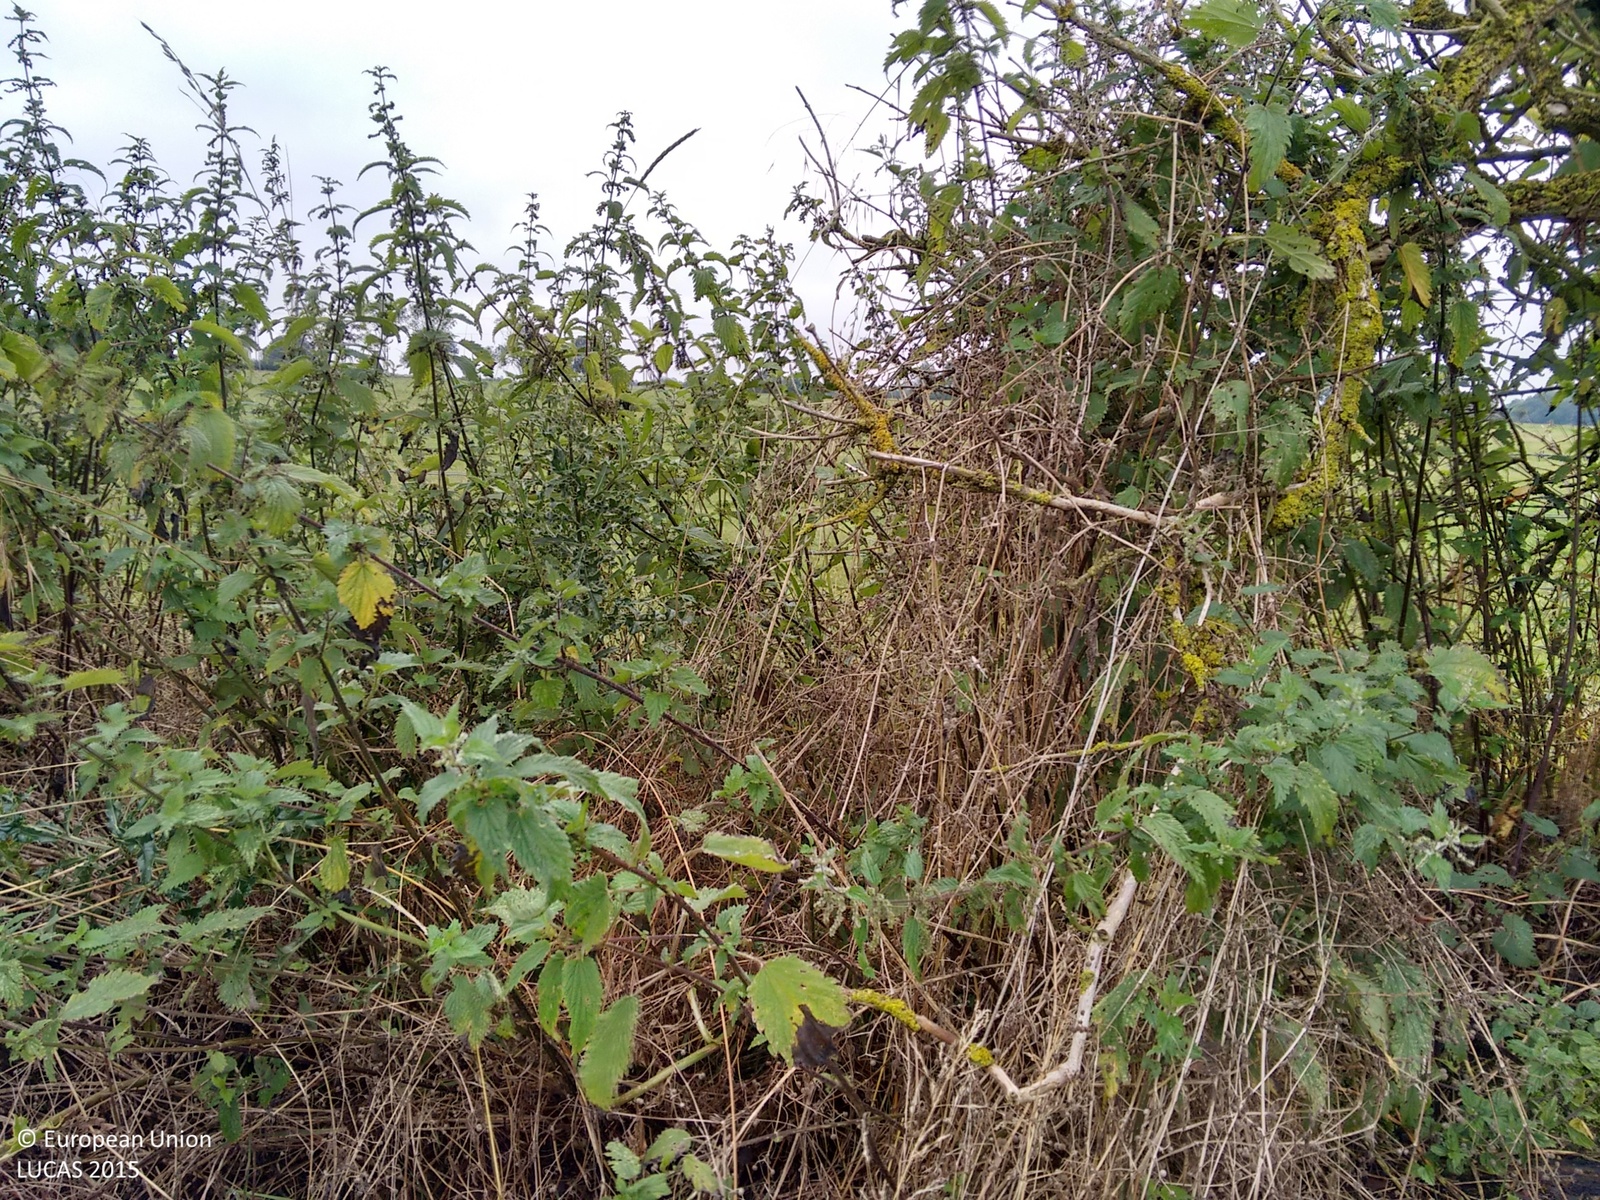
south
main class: Grassland
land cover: Grassland without tree/shrub cover
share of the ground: > 75 %
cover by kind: herbaceous plants 100 %
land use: Agriculture (excluding fallow land and kitchen gardens)
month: September
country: GB
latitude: 52.5061
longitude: -1.3190
